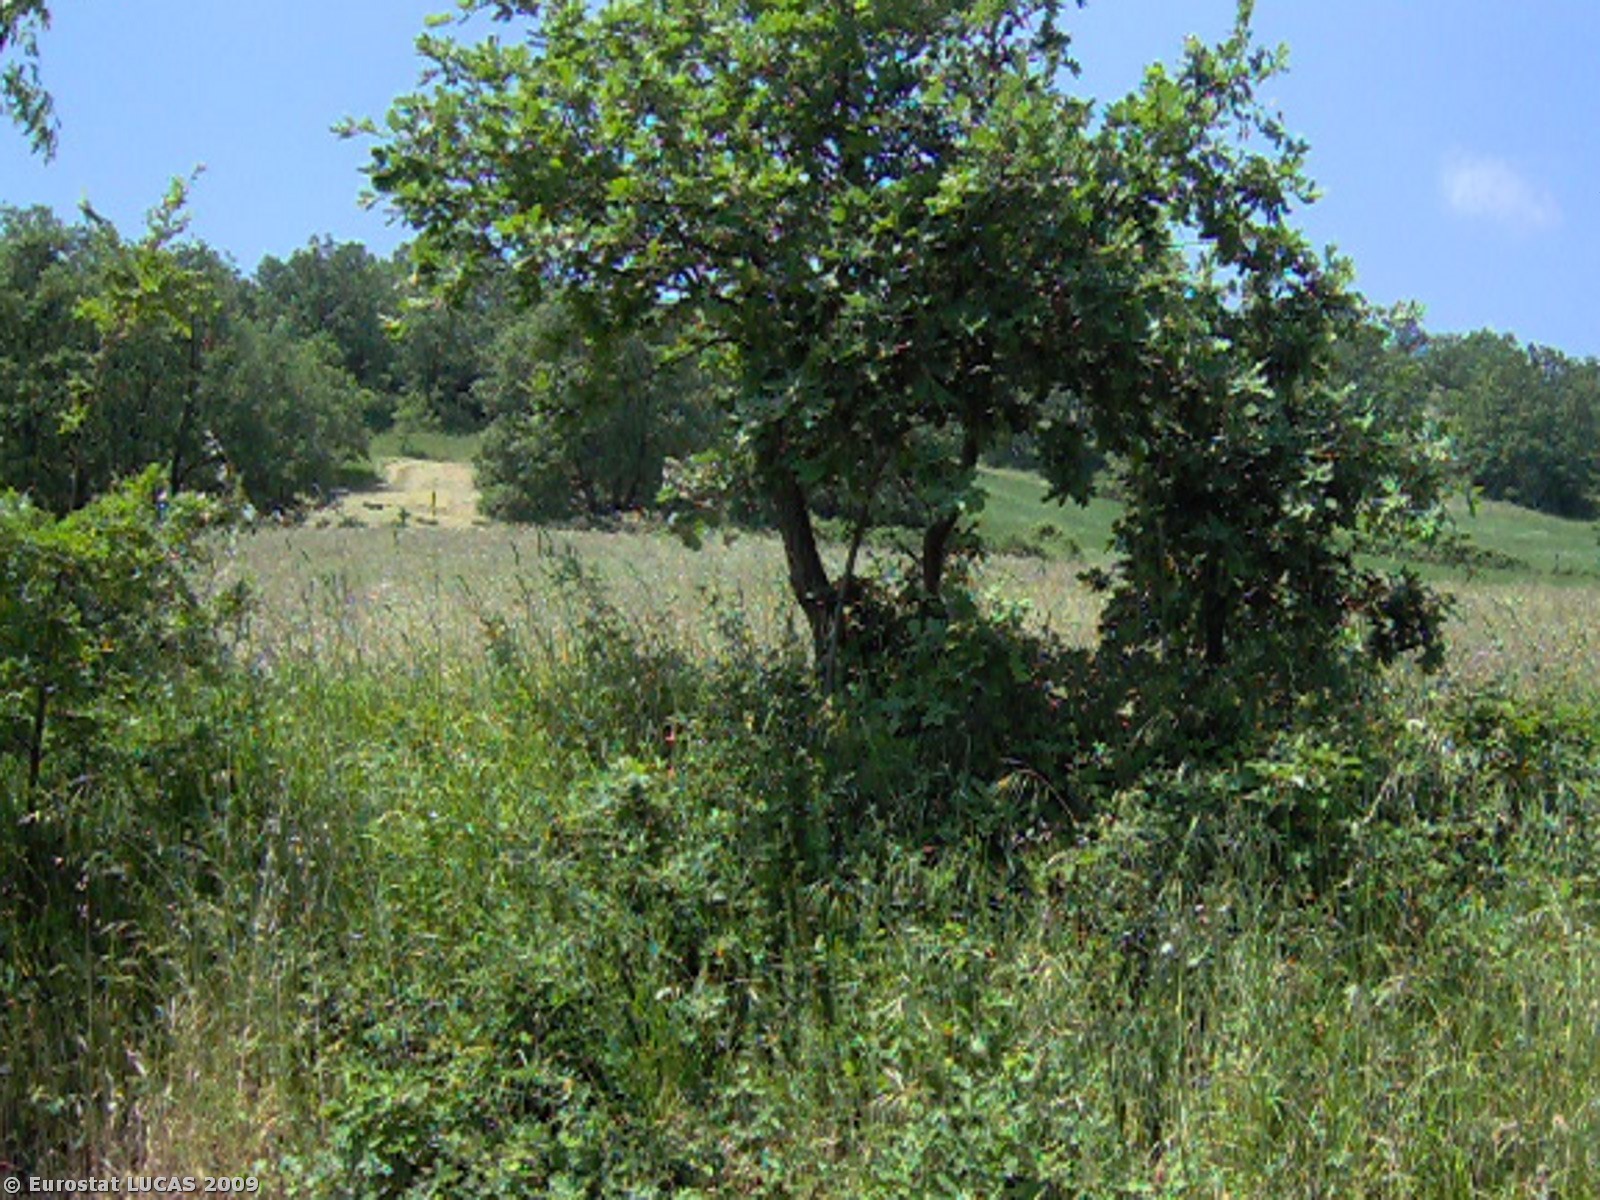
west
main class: Cropland
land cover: Mixed cereals for fodder
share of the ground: > 75 %
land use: Agriculture (excluding fallow land and kitchen gardens)
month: May
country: IT
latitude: 40.6142
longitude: 15.6159
